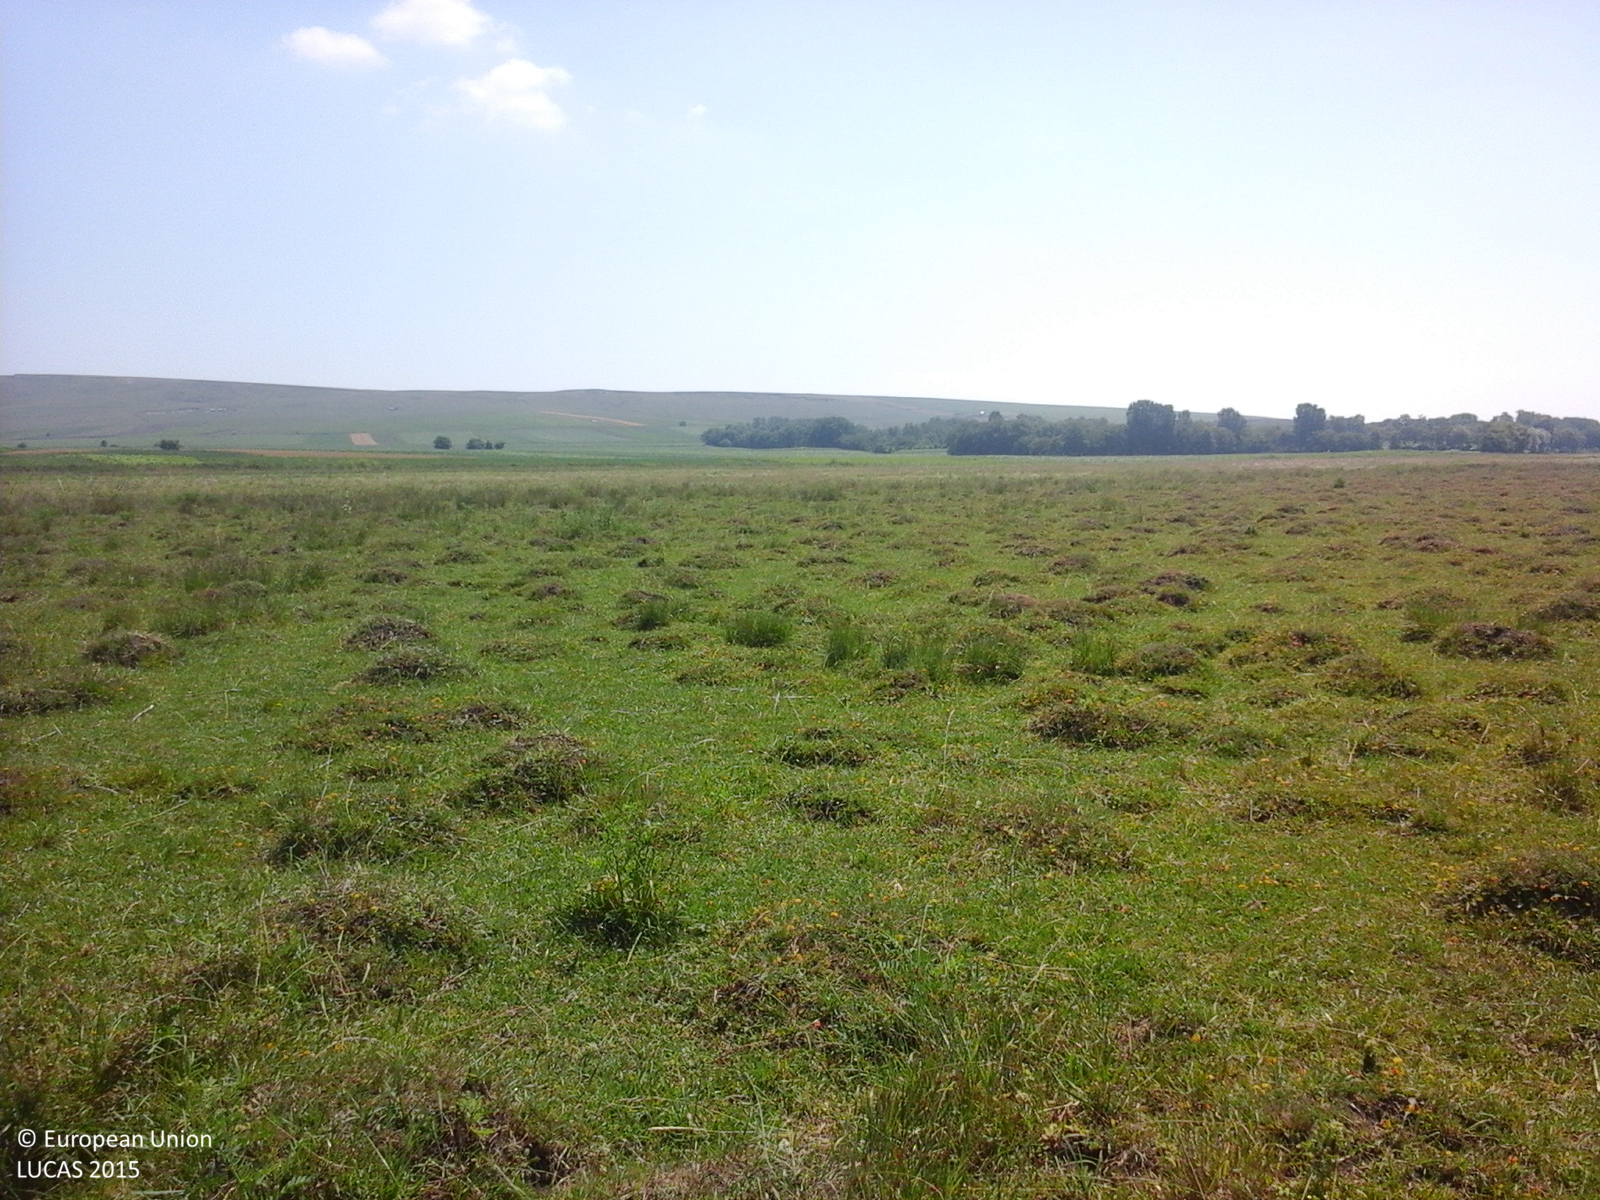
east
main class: Grassland
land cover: Spontaneously vegetated surfaces
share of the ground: > 75 %
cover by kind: herbaceous plants 100 %
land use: Agriculture (excluding fallow land and kitchen gardens)
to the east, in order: Spontaneously vegetated surfaces; Ditches and canals; Spontaneously vegetated surfaces; Tracks; Spontaneously vegetated surfaces; Lucerne
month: June
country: RO
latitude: 47.1771
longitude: 26.8132
